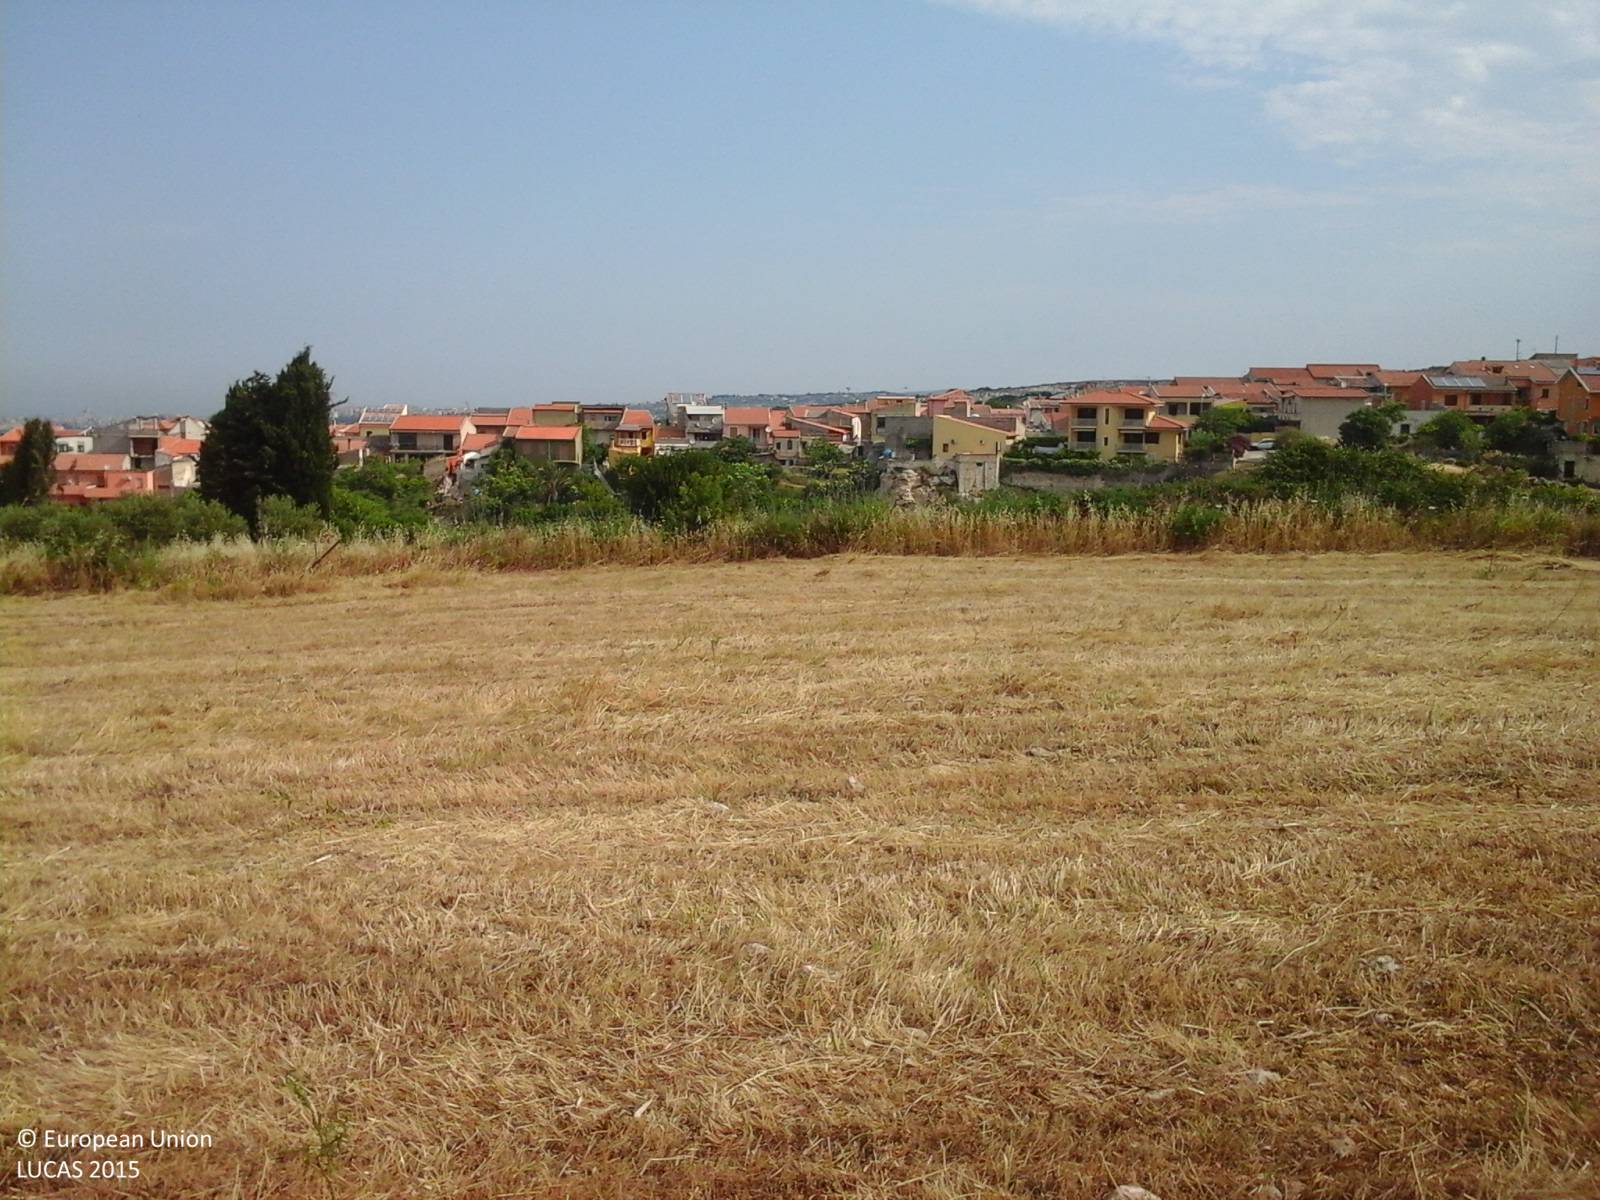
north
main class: Grassland
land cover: Grassland without tree/shrub cover
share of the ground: > 75 %
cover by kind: herbaceous plants 100 %
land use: Agriculture (excluding fallow land and kitchen gardens)
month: June
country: IT
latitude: 40.6737
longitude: 8.5990
